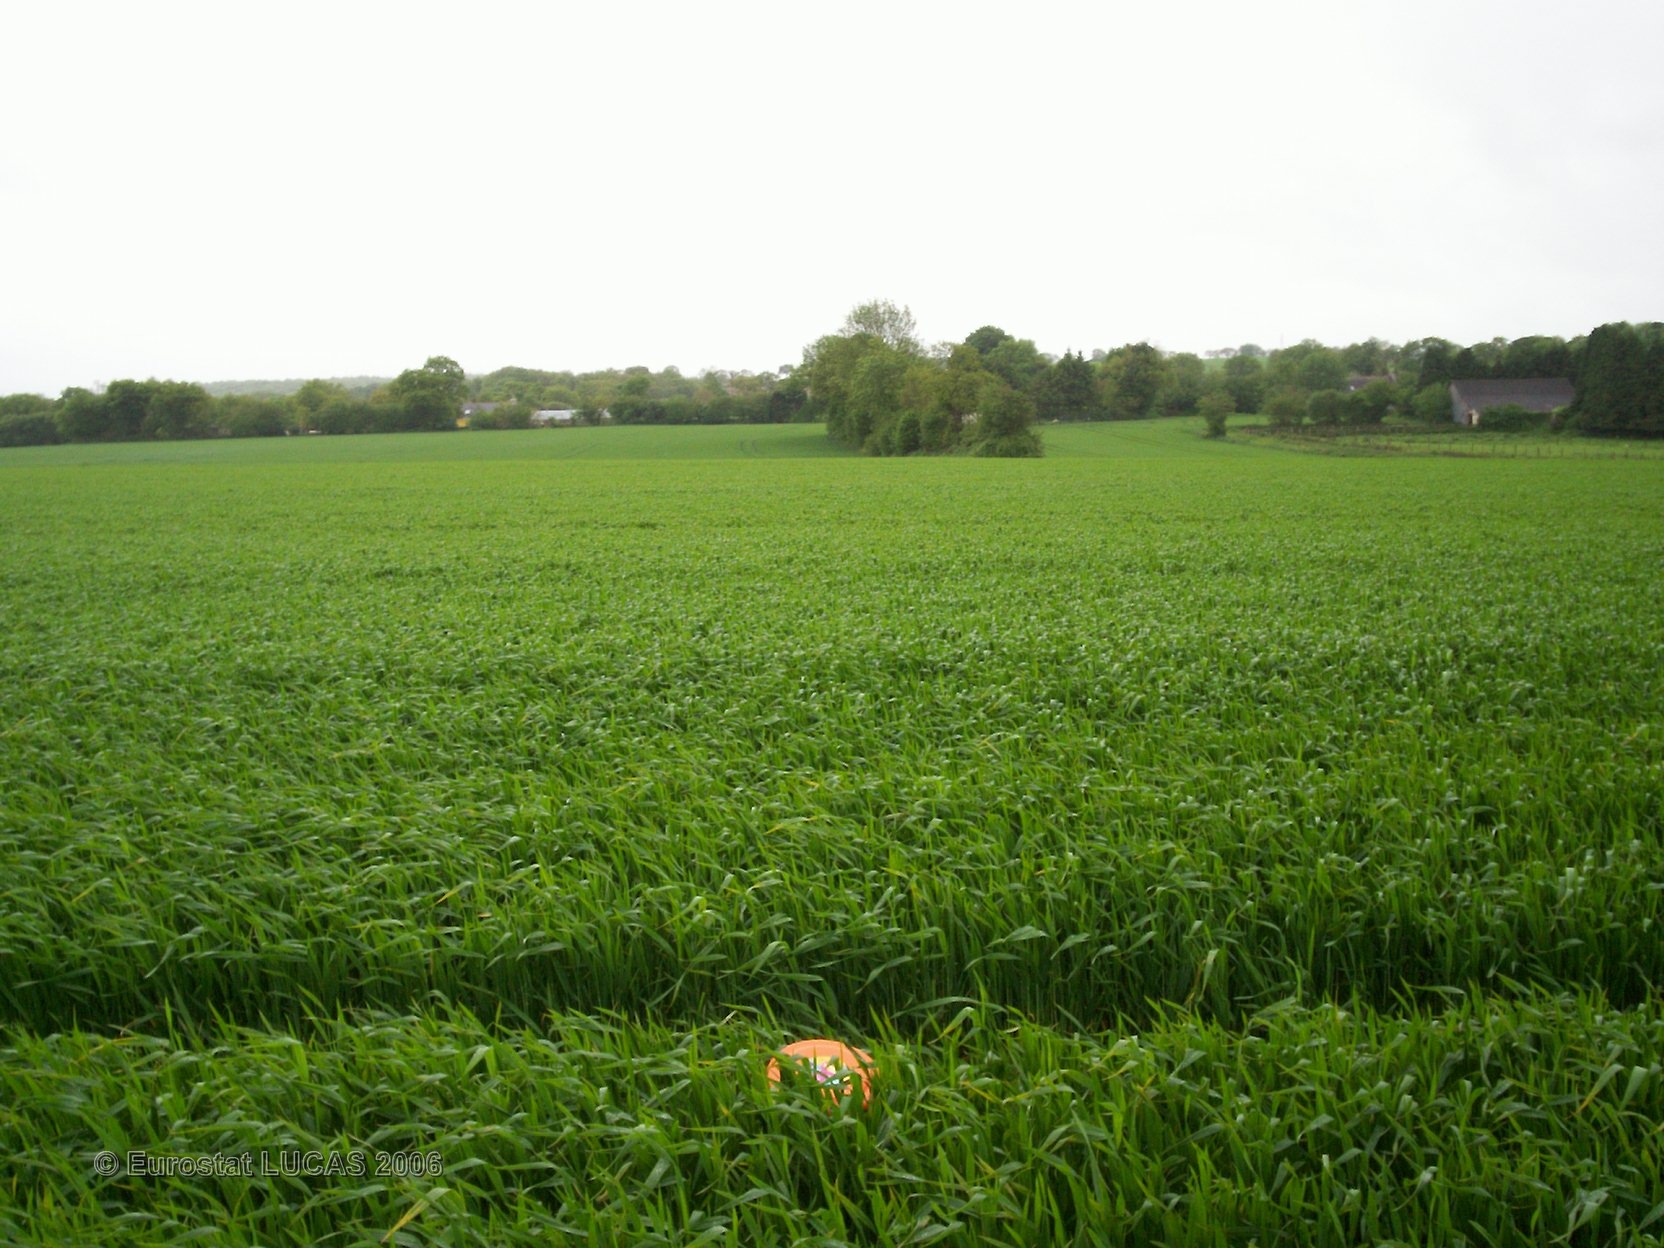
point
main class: Cropland
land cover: Common wheat
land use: Agriculture (excluding fallow land and kitchen gardens)
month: May
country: FR
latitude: 48.3203
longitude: -3.6343
